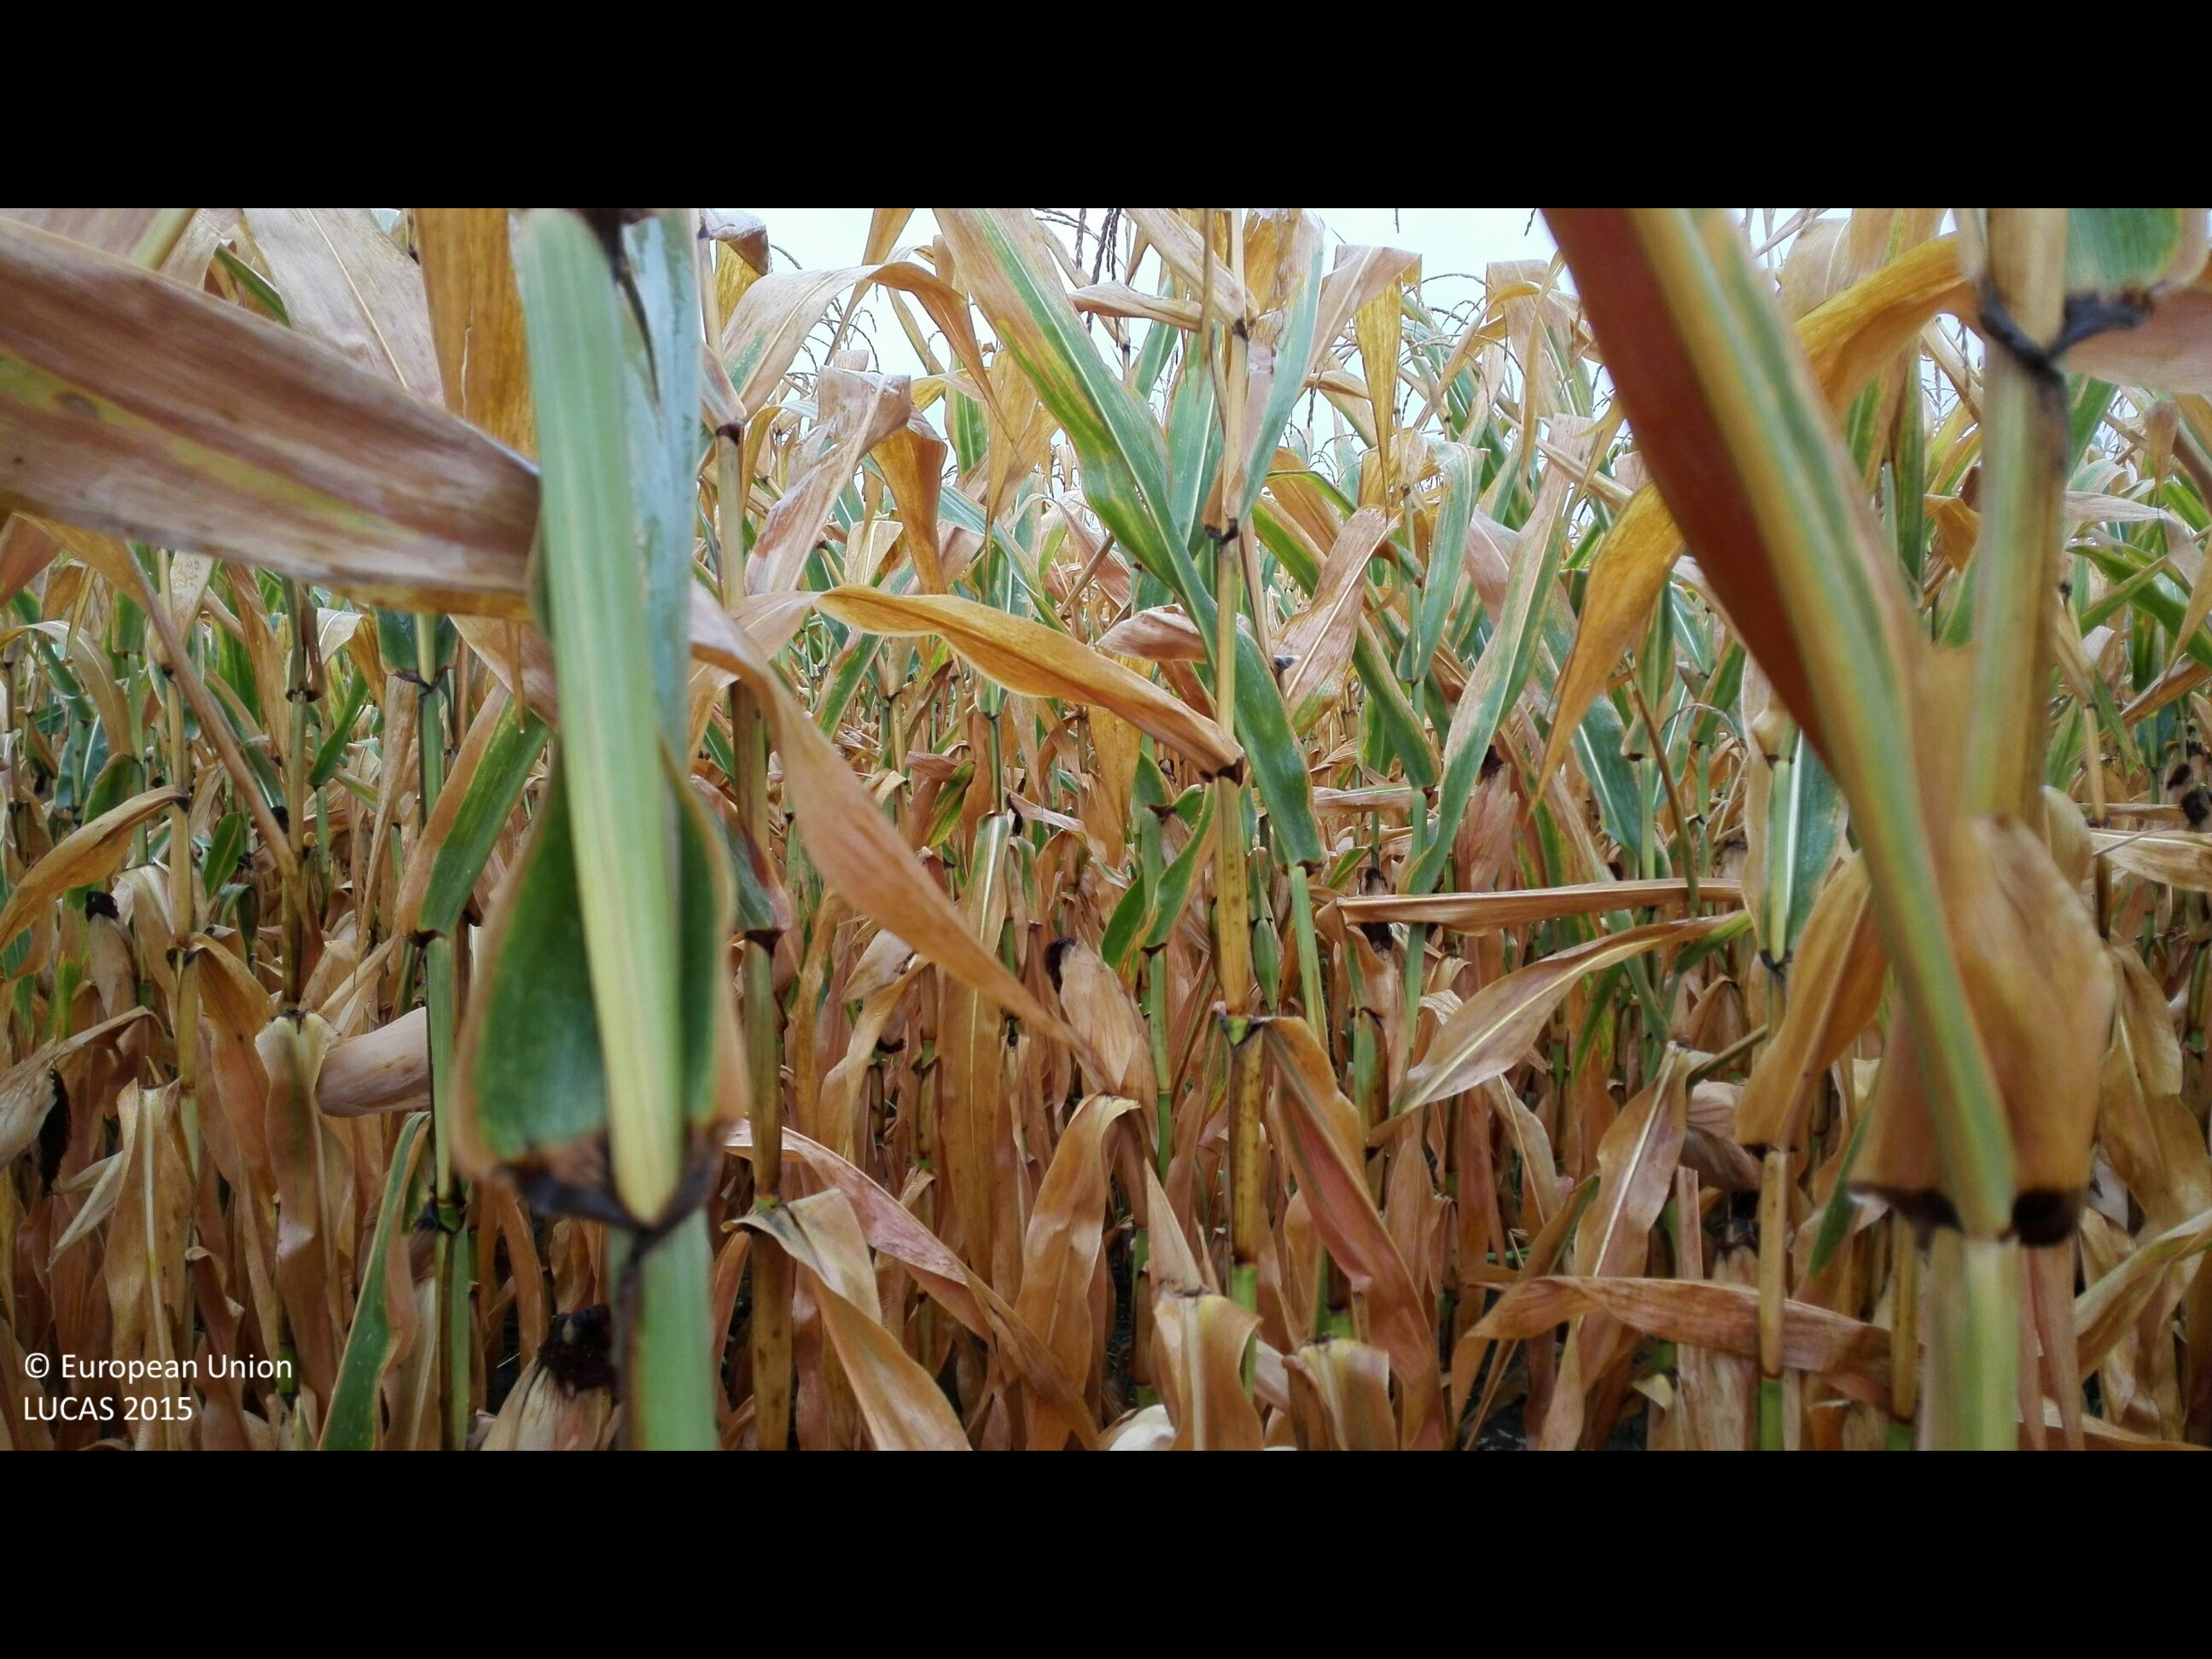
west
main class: Cropland
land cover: Maize
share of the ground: > 75 %
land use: Agriculture (excluding fallow land and kitchen gardens)
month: August
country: HU
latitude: 47.2478
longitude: 21.5769
